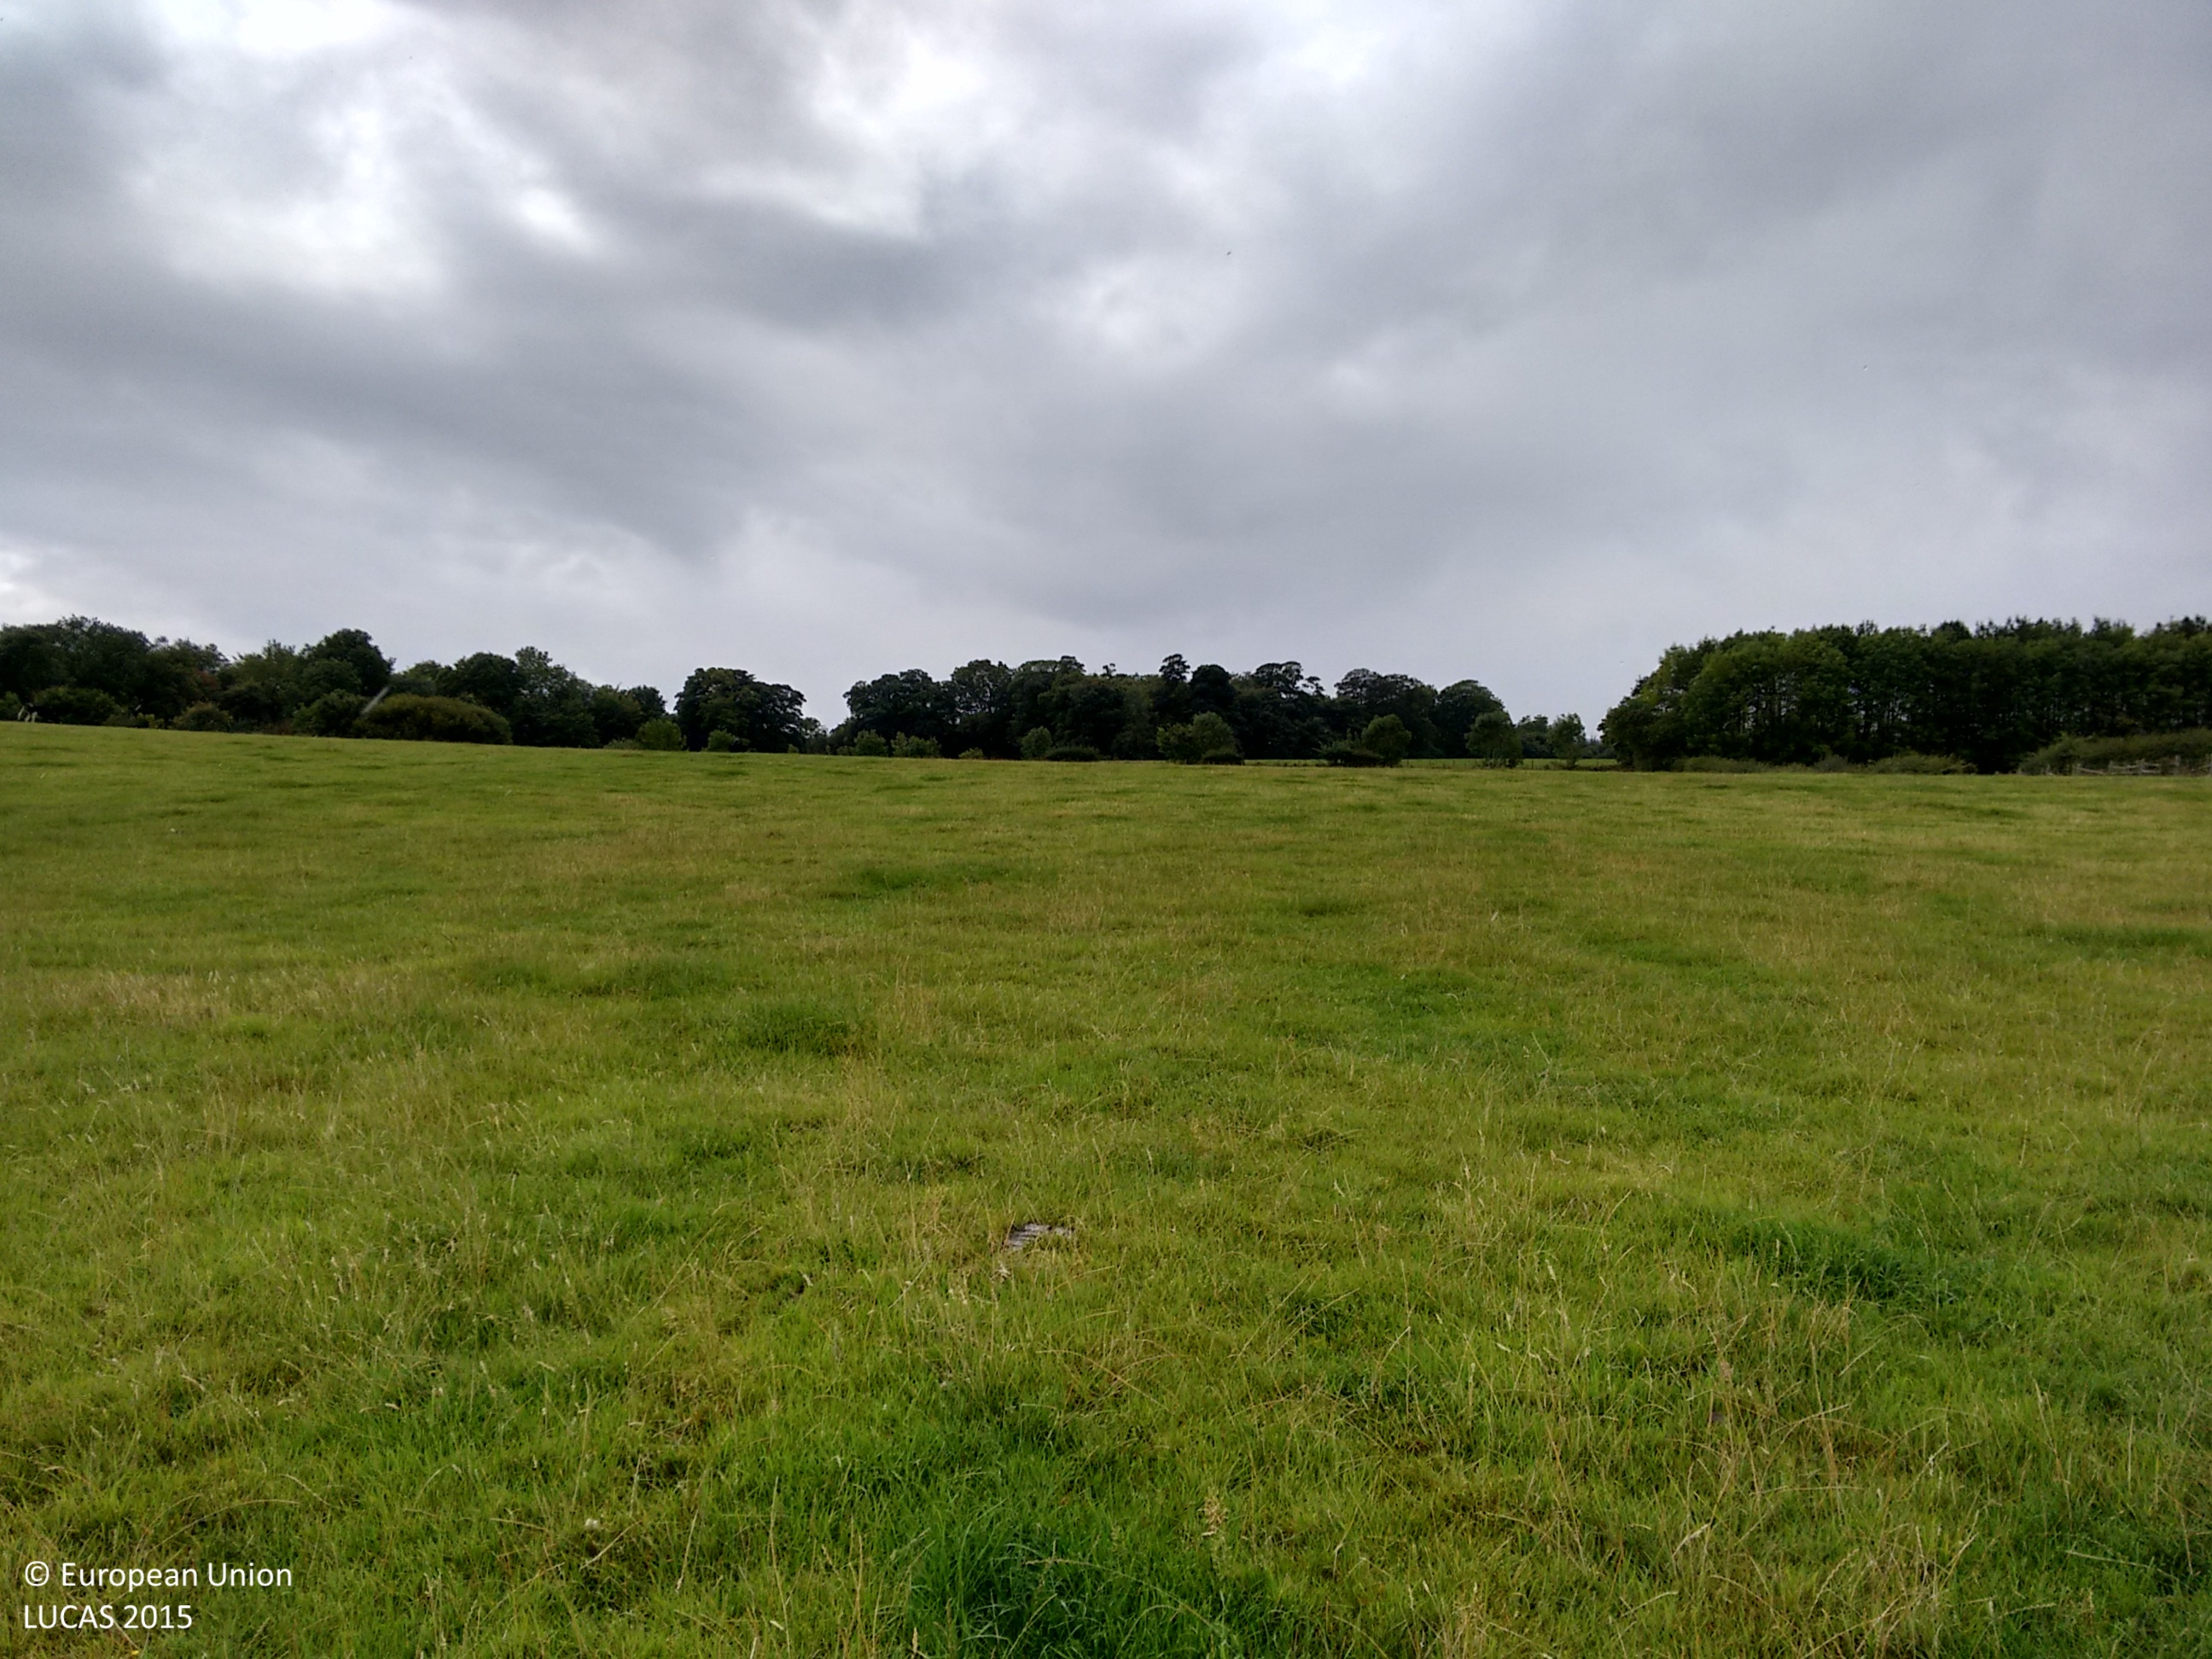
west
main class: Grassland
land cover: Grassland without tree/shrub cover
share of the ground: > 75 %
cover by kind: herbaceous plants 100 %
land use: Agriculture (excluding fallow land and kitchen gardens)
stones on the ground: < 10 %
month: September
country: GB
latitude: 53.0396
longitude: -3.0358
